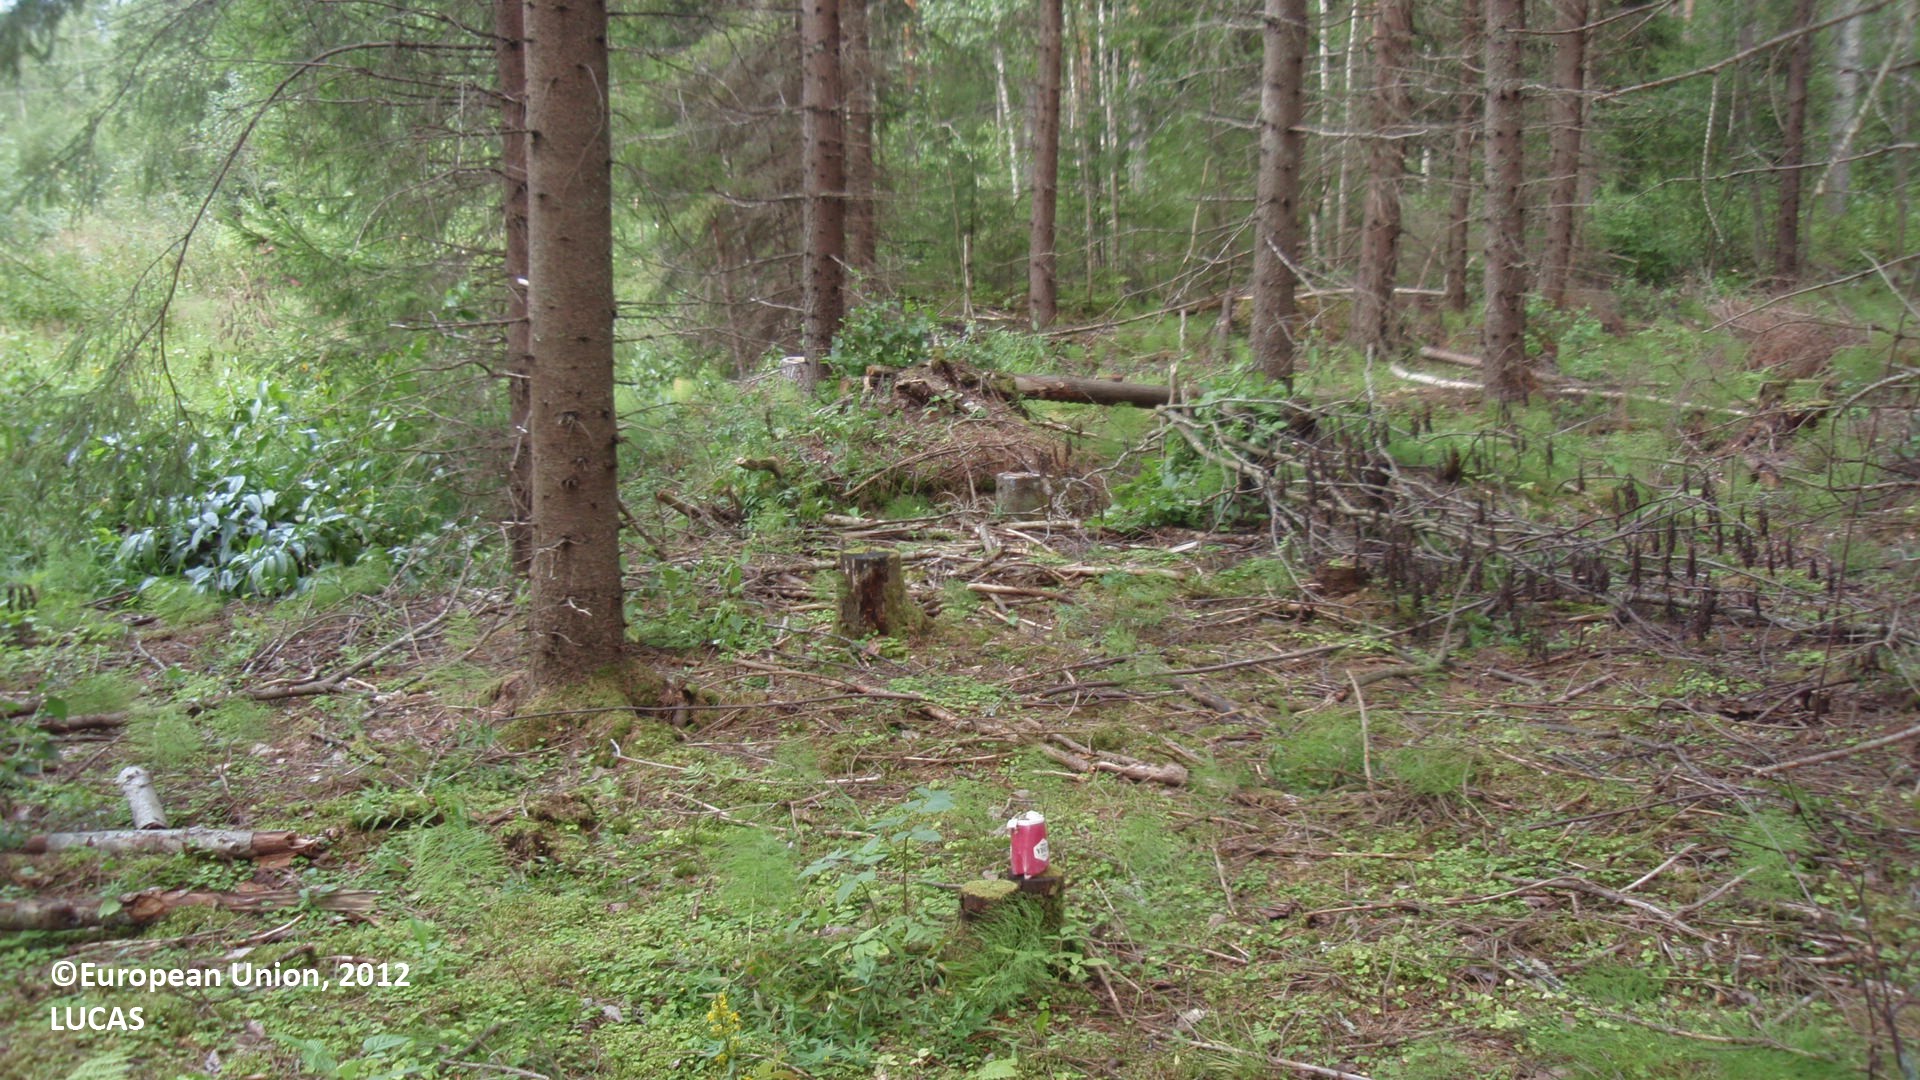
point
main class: Woodland
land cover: Spruce dominated coniferous woodland
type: boreal forest
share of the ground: 50 - 75 %
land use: Forestry
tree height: > 5 m
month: August
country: FI
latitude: 61.0369
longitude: 27.6437
